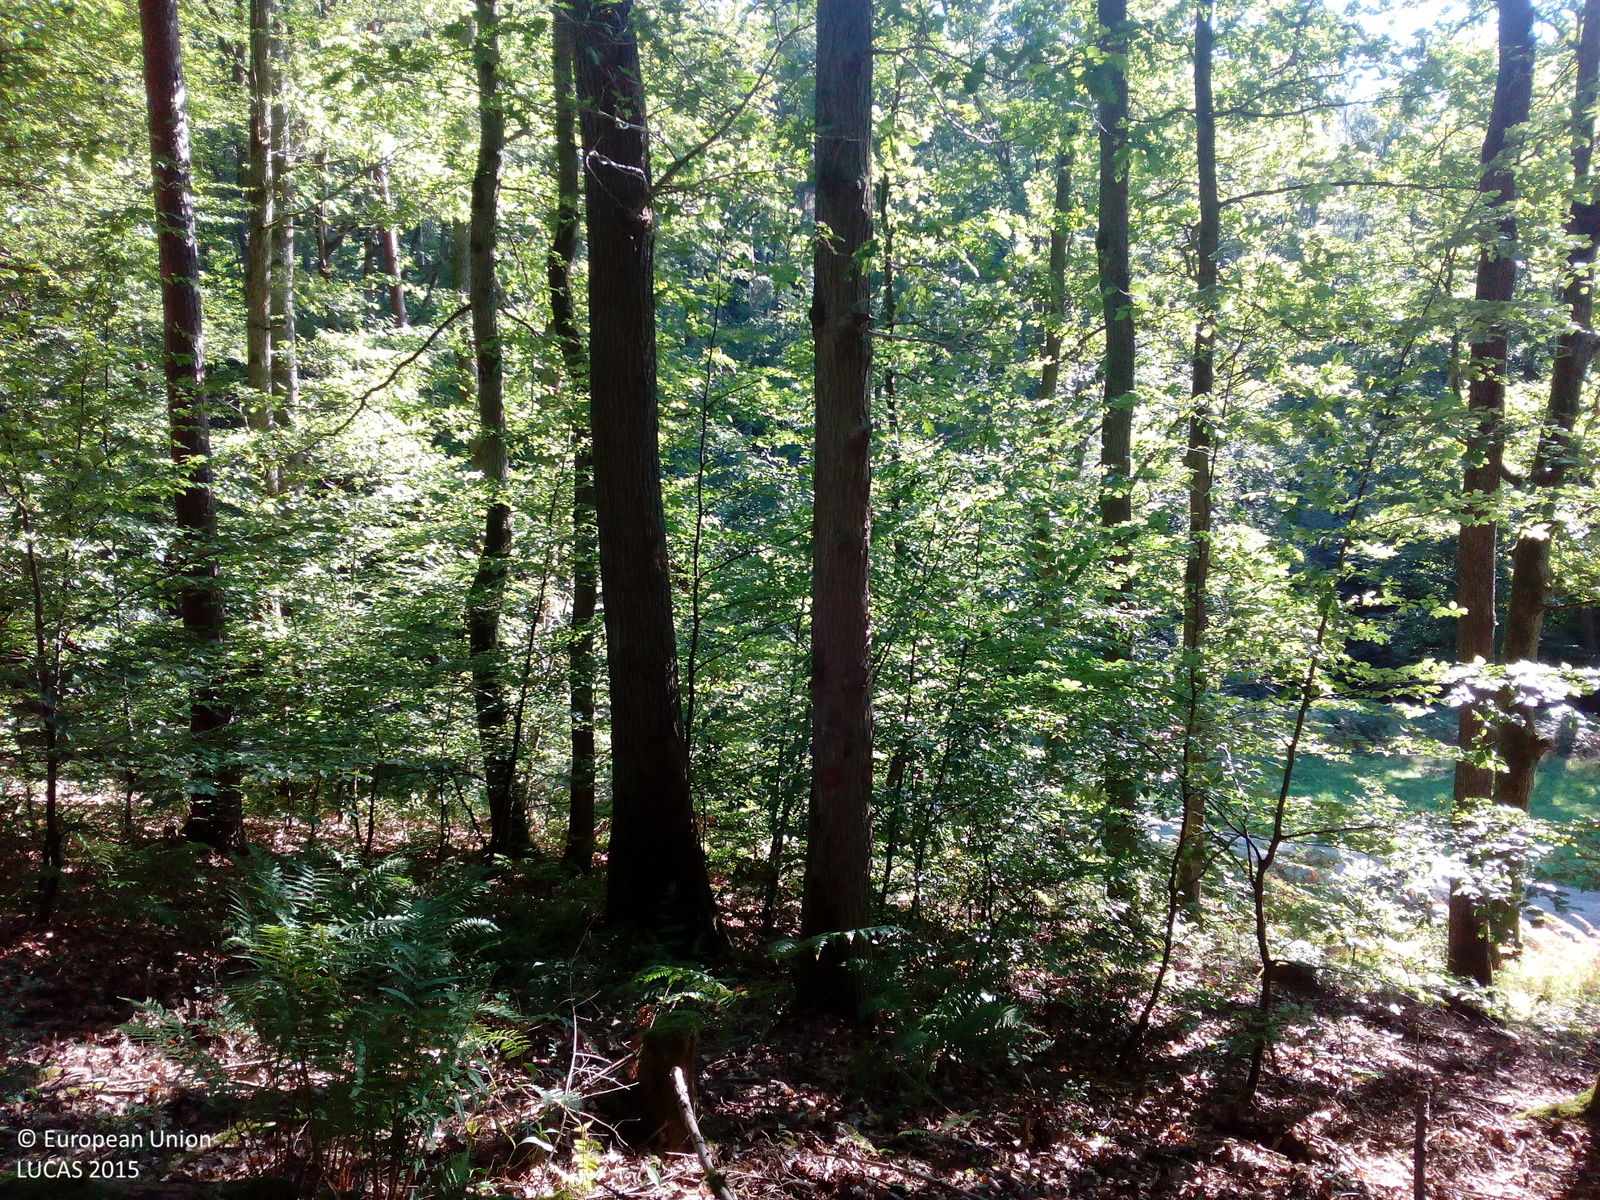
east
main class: Woodland
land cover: Spruce dominated coniferous woodland
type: hemiboreal forest and nemoral coniferous forest and mixed broadleaved-coniferous forest
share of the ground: > 75 %
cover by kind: coniferous forest trees 90 %, unconsolidated bare surface 10 %
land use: Forestry
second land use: Amenities, museums, leisure
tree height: > 5 m
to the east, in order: Spruce dominated coniferous woodland; Pine dominated mixed woodland; Shruby margins; Tracks; Grassland without tree/shrub cover; Spruce dominated mixed woodland; Rivers and streams; Pine dominated mixed woodland; Tracks; Pine dominated mixed woodland; Tracks; Pine dominated mixed woodland; Tracks; Pine dominated mixed woodland
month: September
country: DE
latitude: 49.9137
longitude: 9.5684
